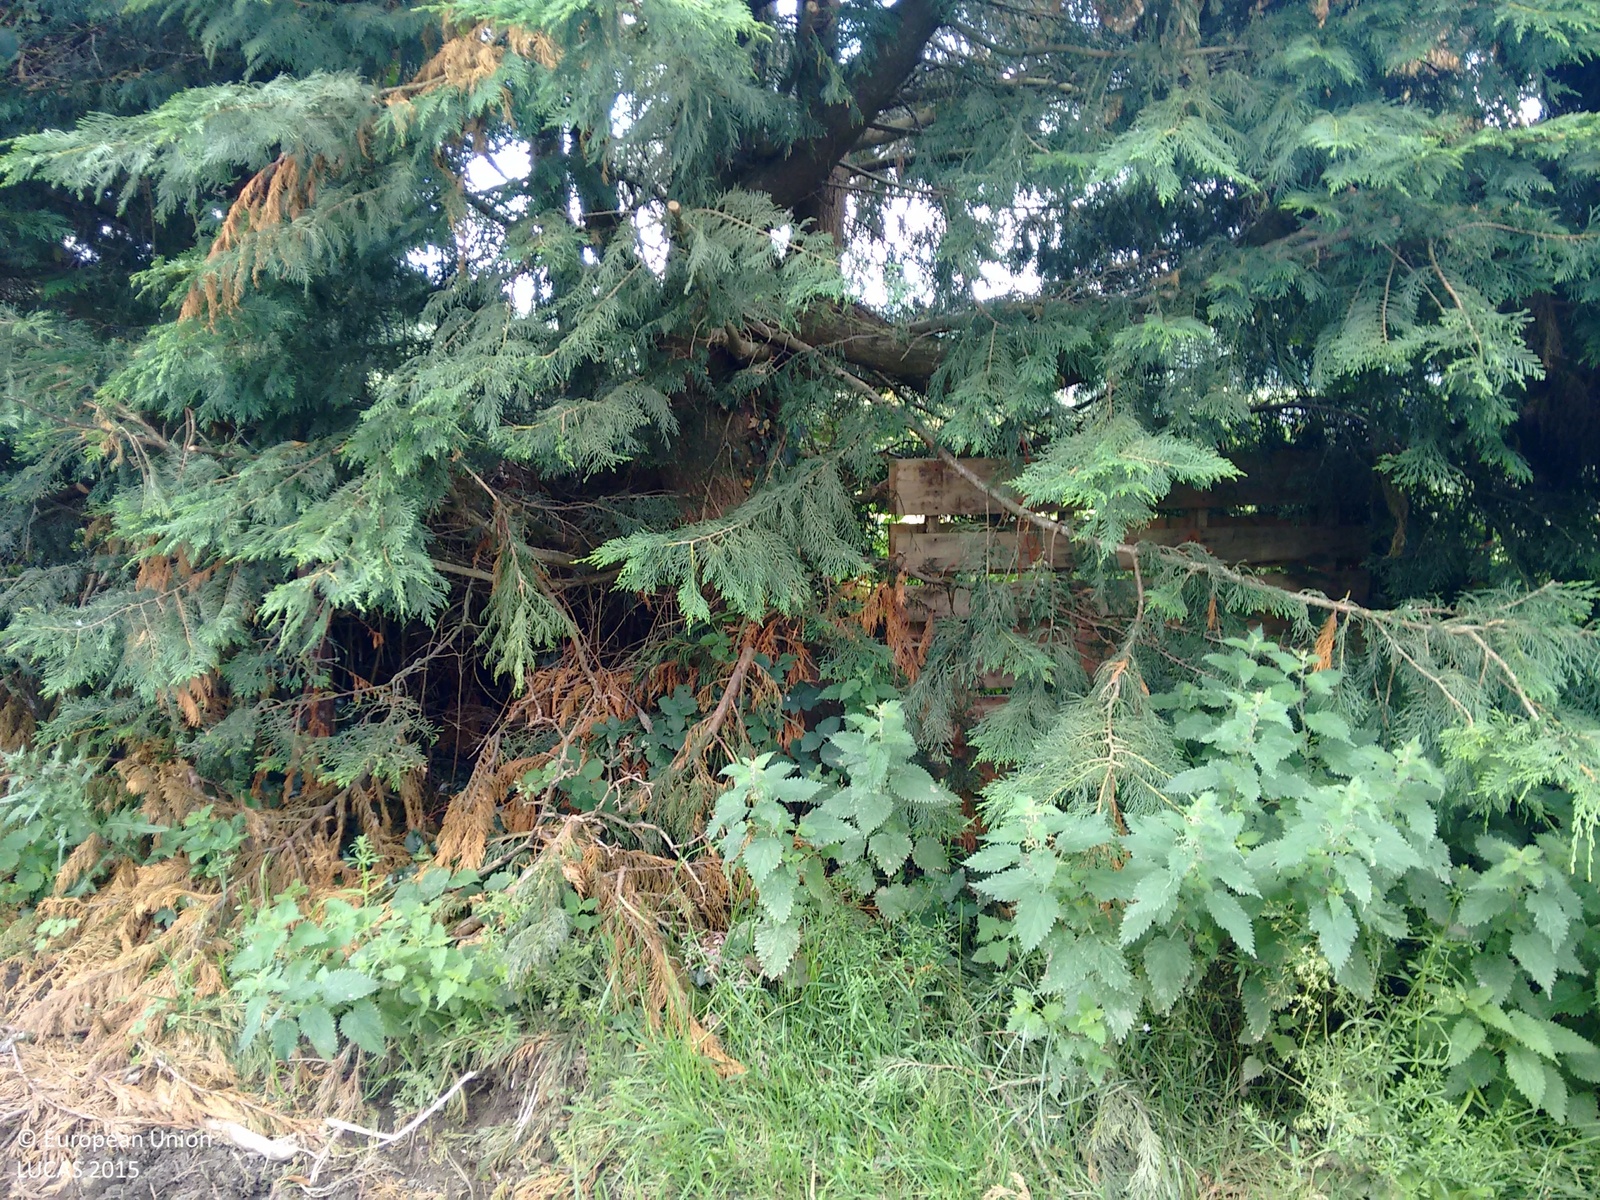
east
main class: Grassland
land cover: Grassland without tree/shrub cover
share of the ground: > 75 %
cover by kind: herbaceous plants 100 %
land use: Agriculture (excluding fallow land and kitchen gardens)
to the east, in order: Grassland without tree/shrub cover; Abandoned hedges; Fences; Grassland without tree/shrub cover; Electric lines; Grassland without tree/shrub cover
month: July
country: IE
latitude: 52.5999
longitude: -7.5683
